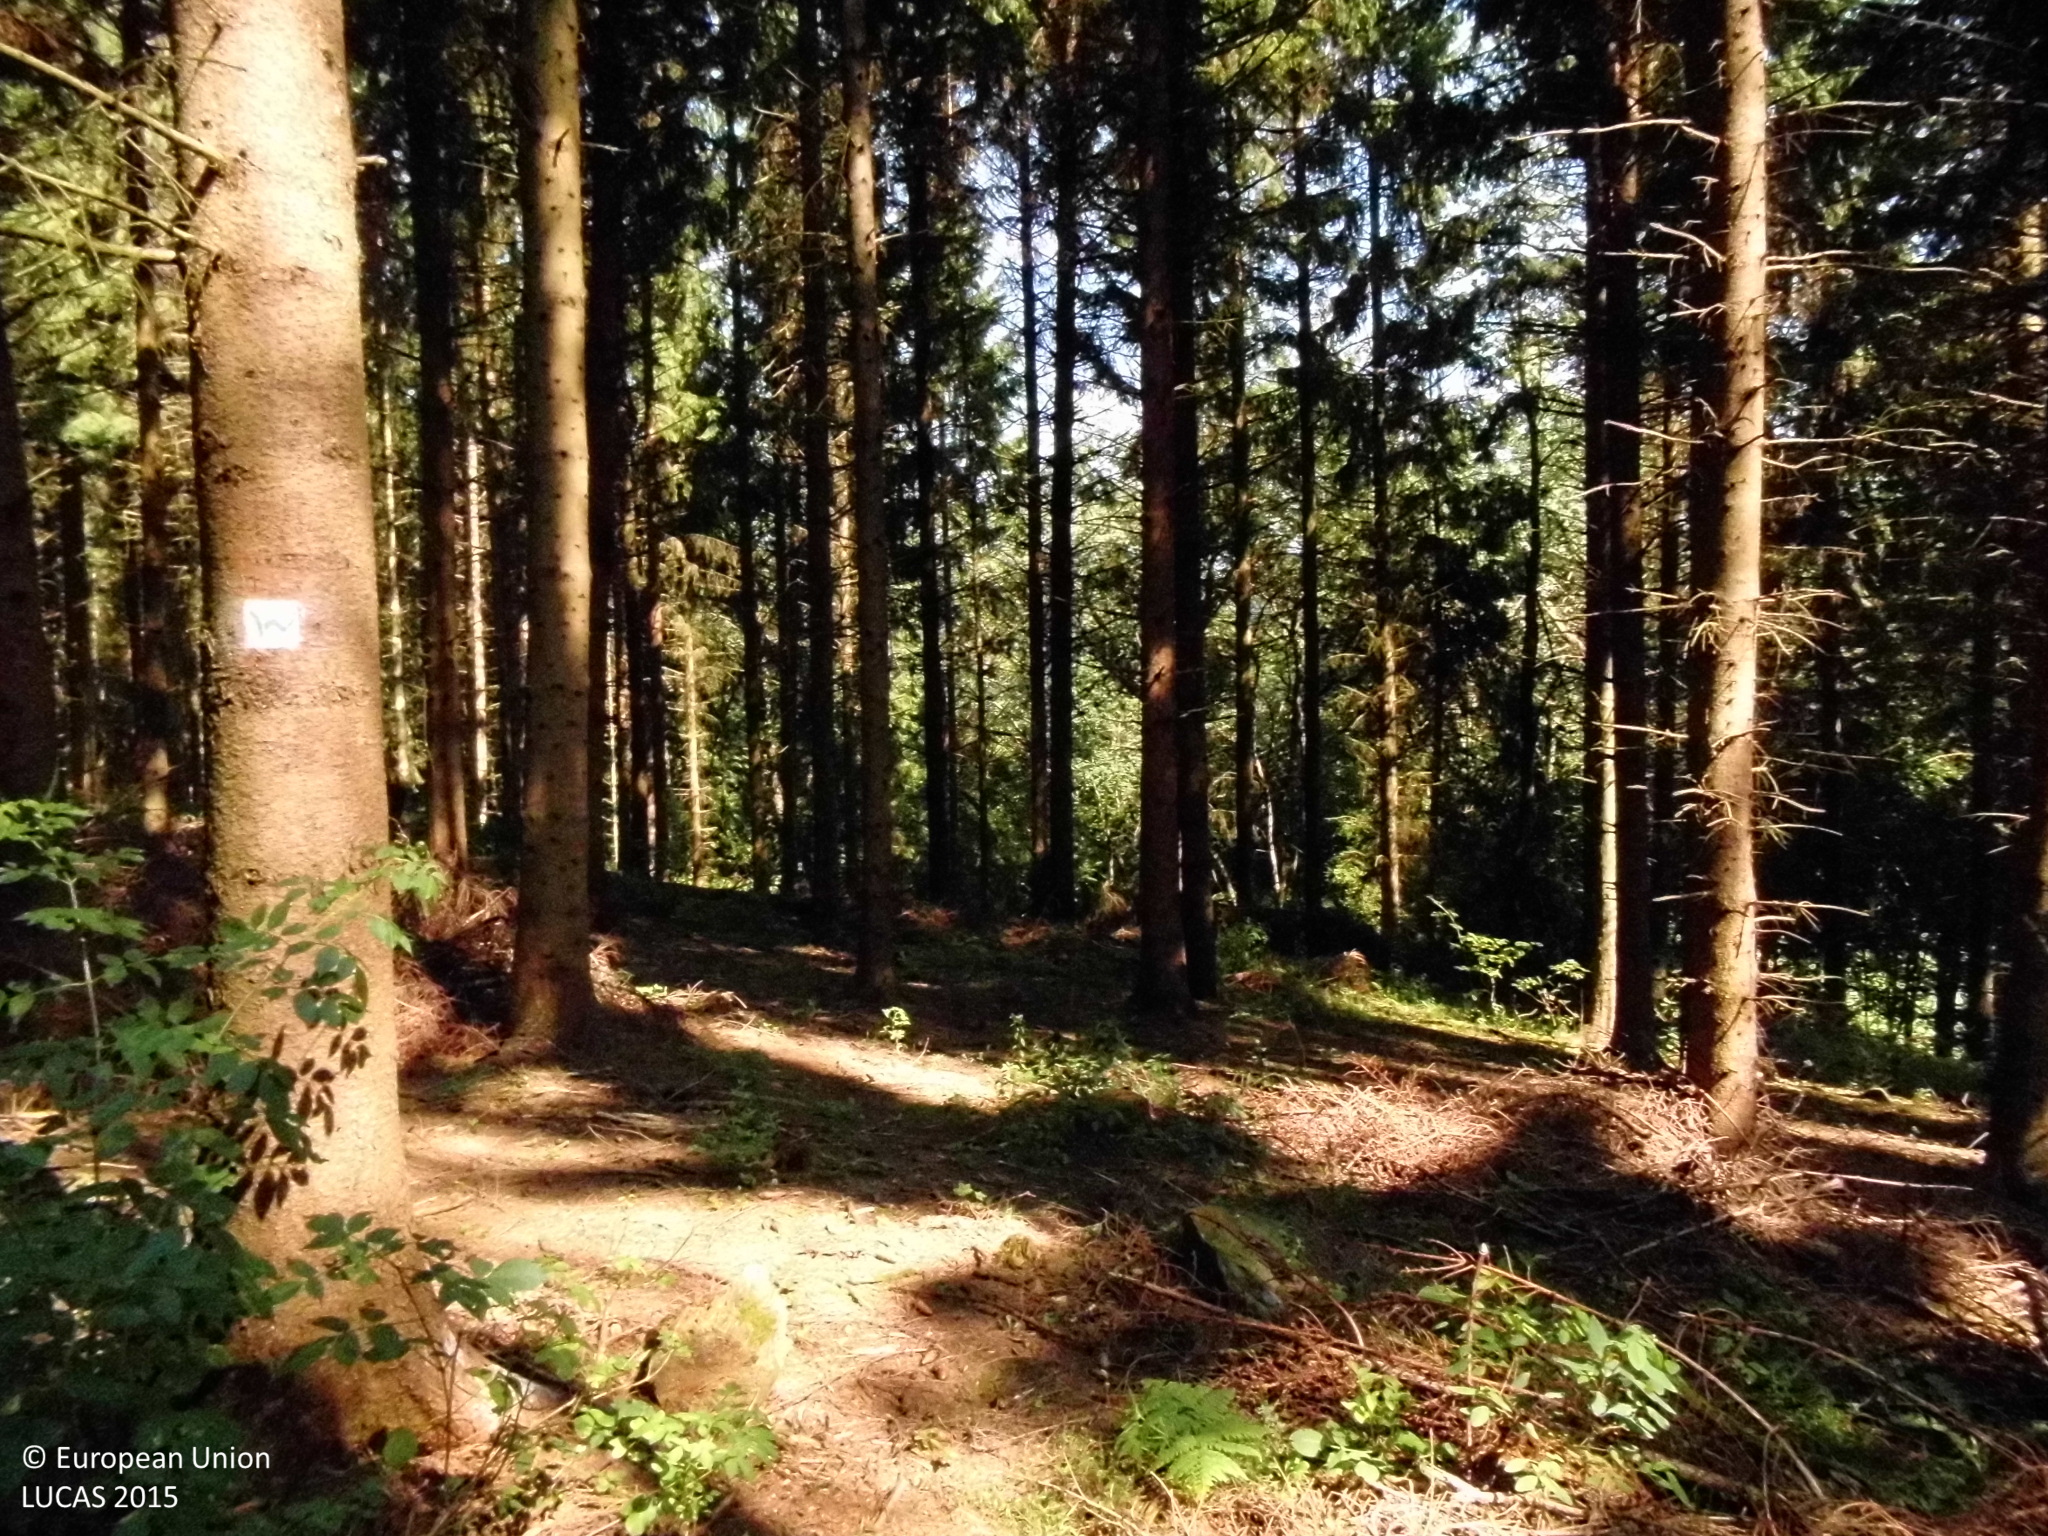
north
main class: Woodland
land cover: Spruce dominated coniferous woodland
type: hemiboreal forest and nemoral coniferous forest and mixed broadleaved-coniferous forest
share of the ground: > 75 %
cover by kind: coniferous forest trees 75 %, herbaceous plants 10 %, broadleaved forest trees 5 %, shrubs 5 %, unconsolidated bare surface 5 %
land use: Forestry
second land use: Amenities, museums, leisure
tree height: > 5 m
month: August
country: DE
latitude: 50.5626
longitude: 8.0099
